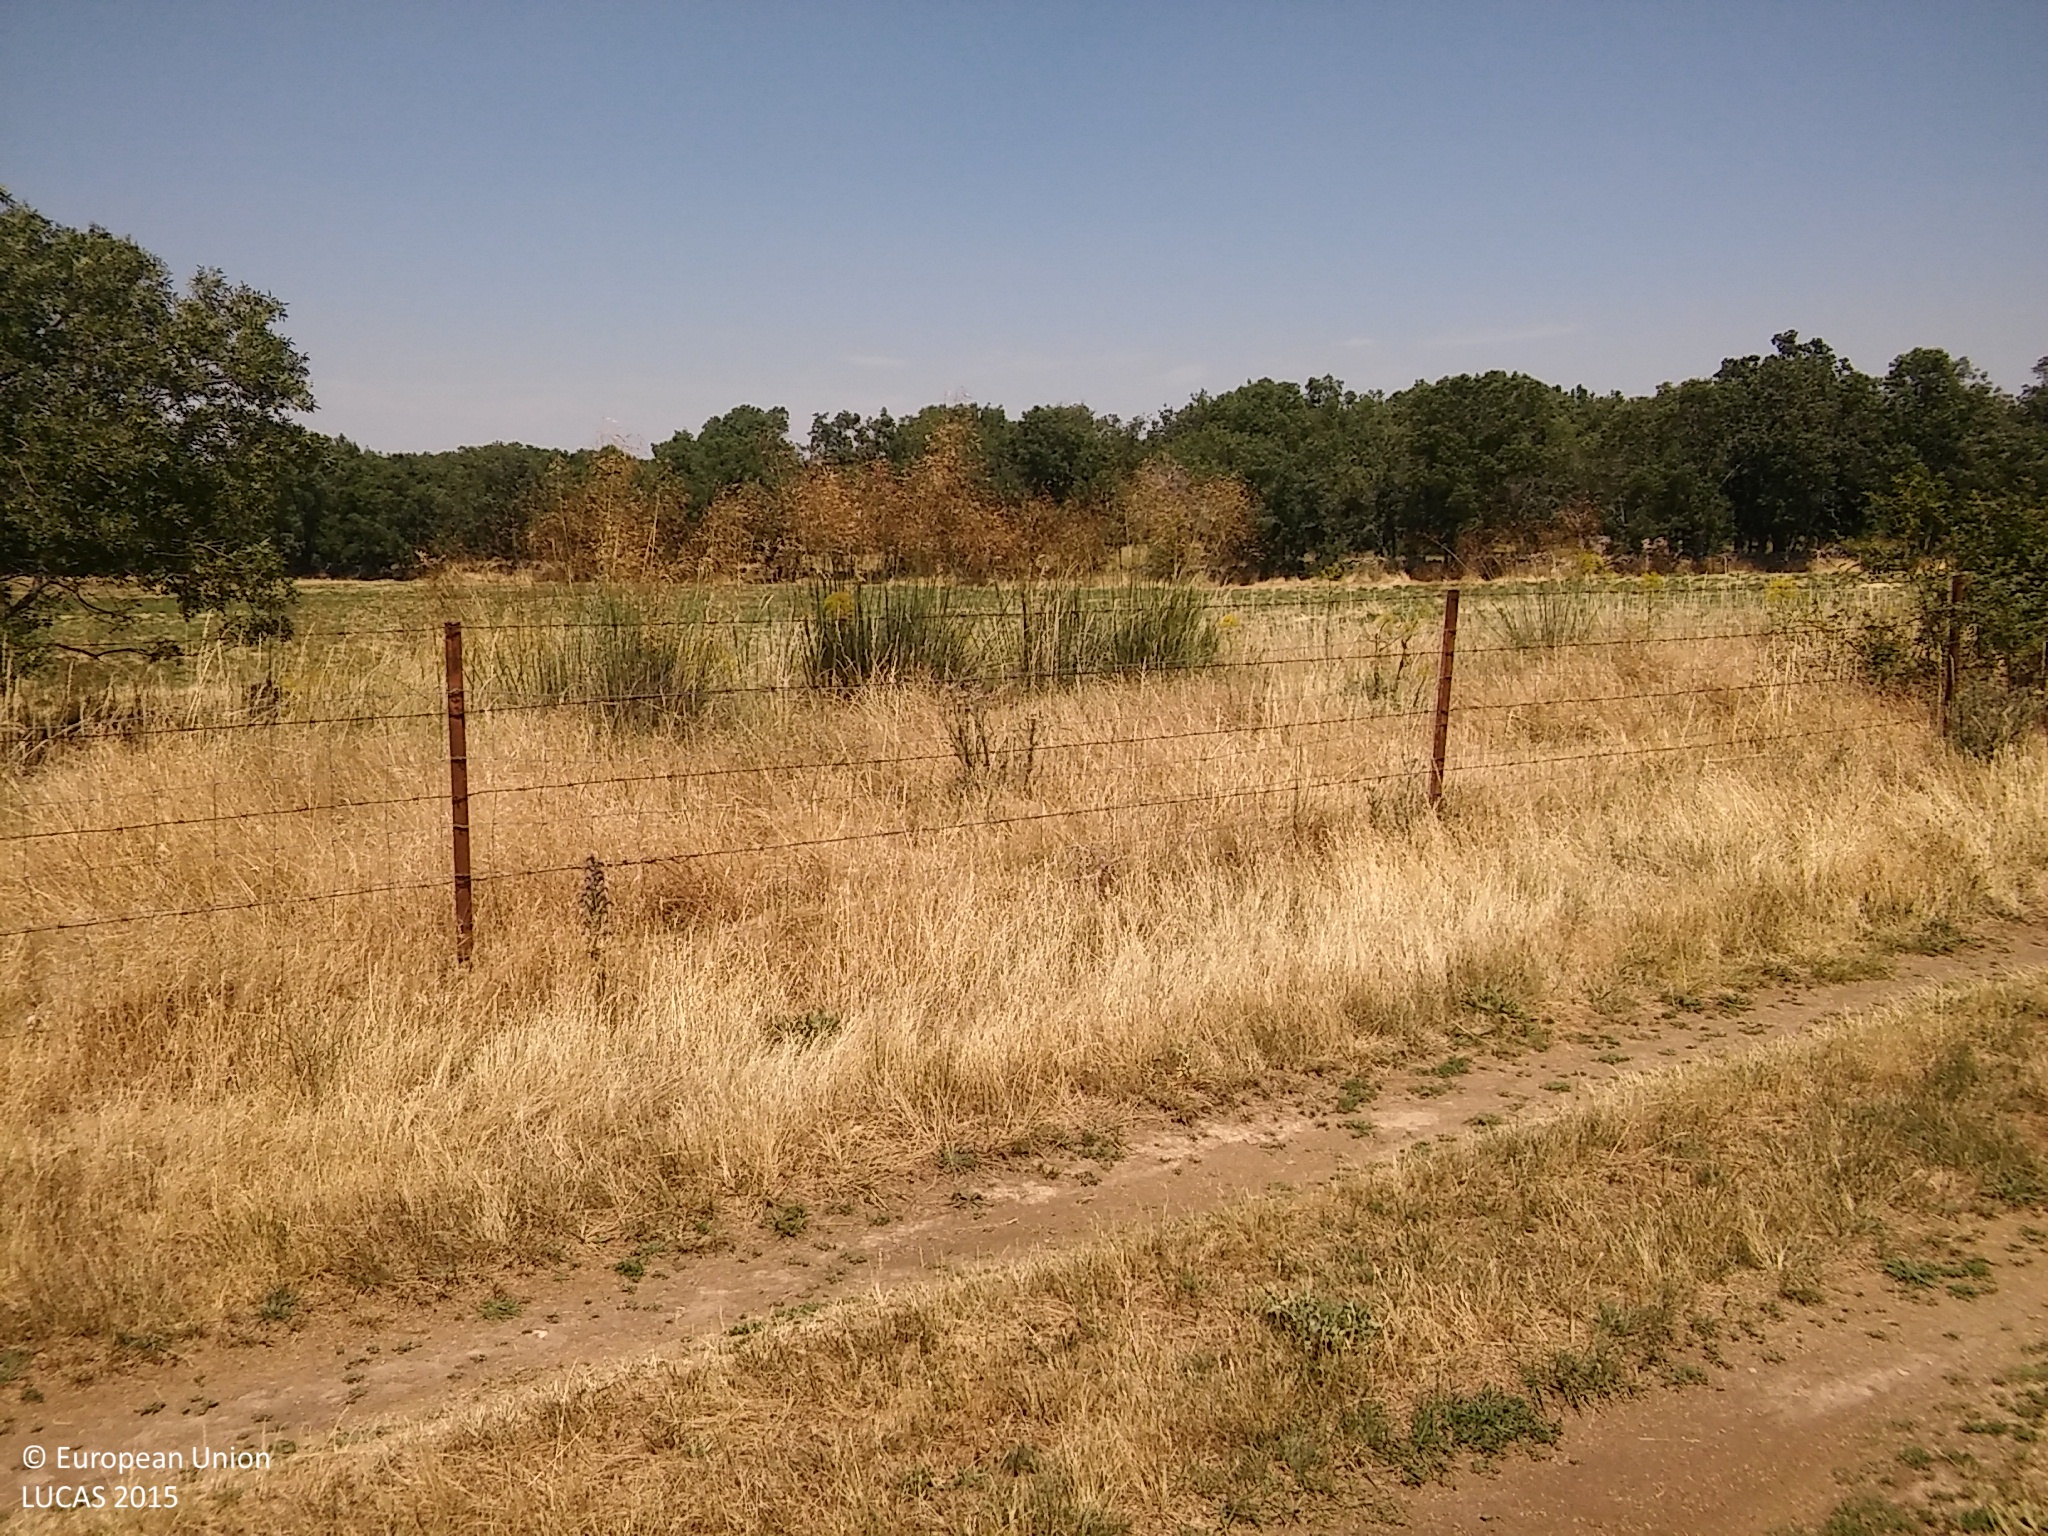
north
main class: Grassland
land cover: Grassland without tree/shrub cover
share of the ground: > 75 %
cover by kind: herbaceous plants 100 %
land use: Agriculture (excluding fallow land and kitchen gardens)
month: June
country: ES
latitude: 41.0806
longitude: -3.9401
